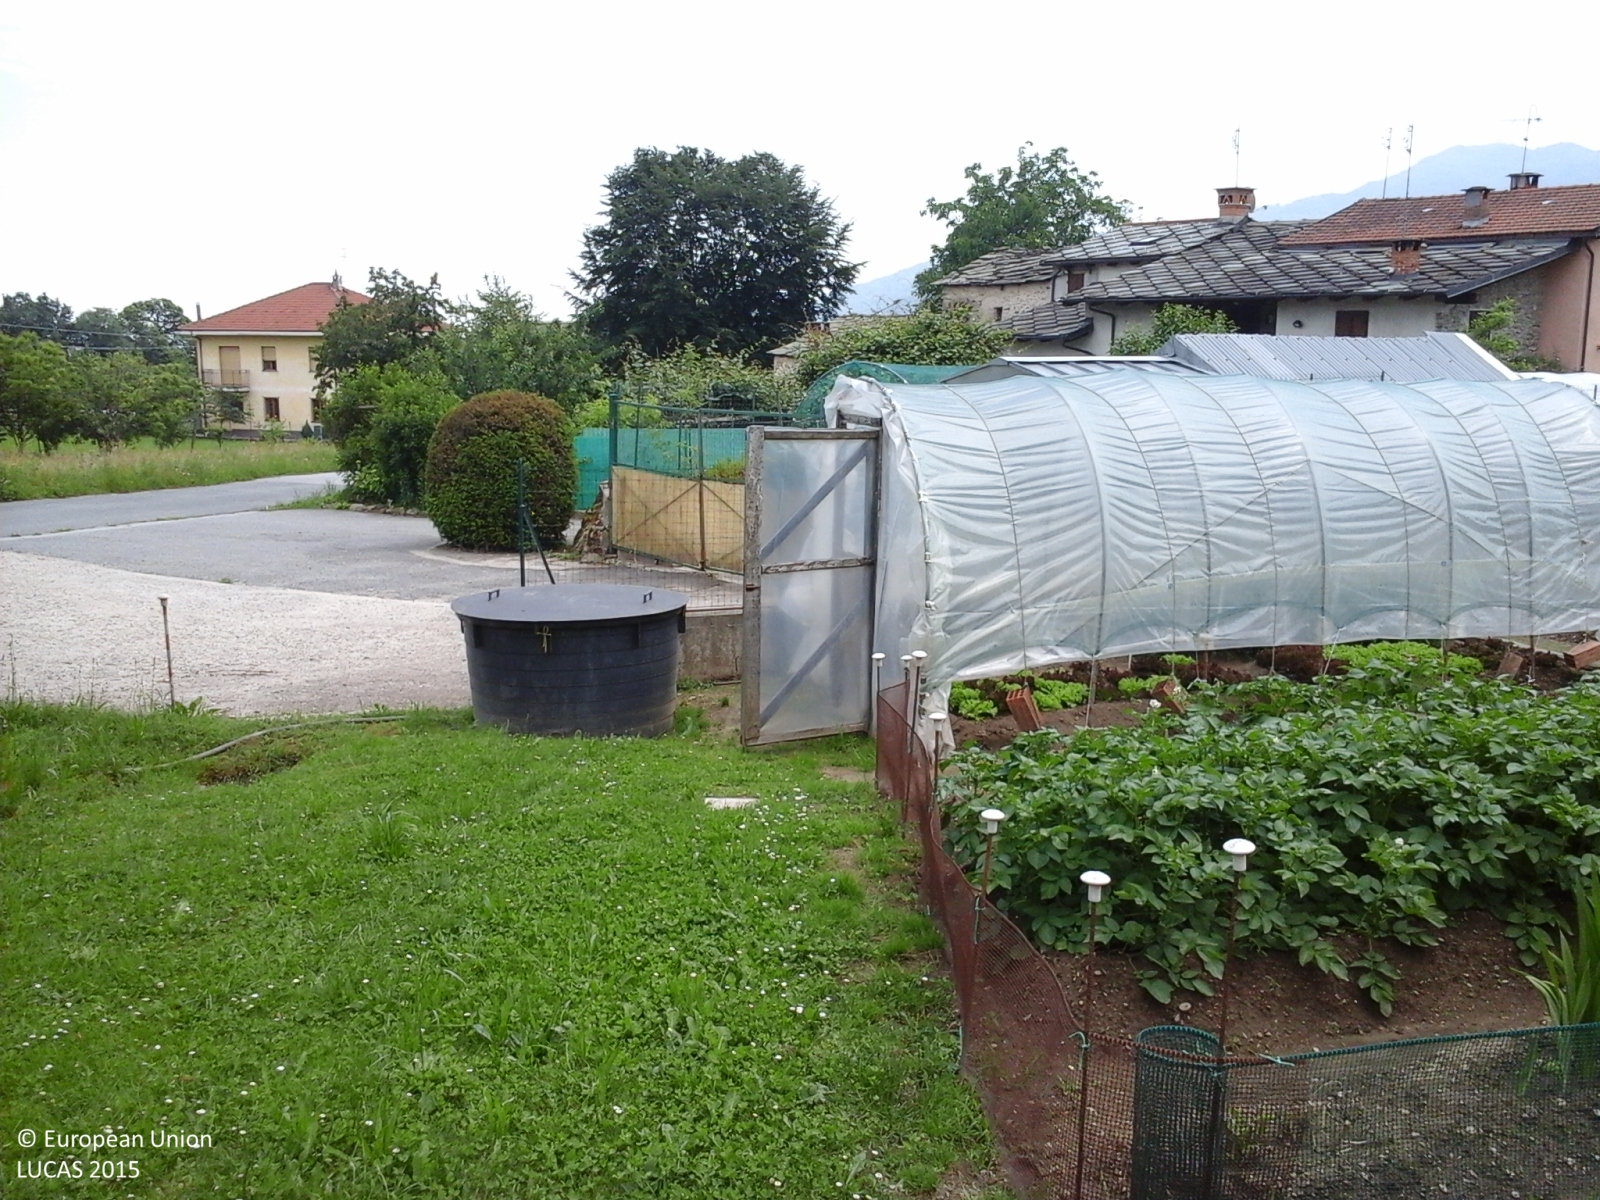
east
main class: Grassland
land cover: Grassland with sparse tree/shrub cover
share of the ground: > 75 %
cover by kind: herbaceous plants 95 %, broadleaved forest trees 5 %
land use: Agriculture (excluding fallow land and kitchen gardens)
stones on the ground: < 10 %
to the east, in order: Grassland with sparse tree/shrub cover; Artificial constructions in urban areas; Managed hedges; Grassland without tree/shrub cover; Artificial constructions in urban areas; Other fruit trees and berries; Fences; Ditches and canals; Abandoned hedges; Other fruit trees and berries; Electric lines; Other fruit trees and berries; Broadleaved woodland; Apple fruit; Fences; Grass margins; Broadleaved woodland; Ditches and canals; Other fruit trees and berries
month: May
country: IT
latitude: 44.7302
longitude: 7.2903
